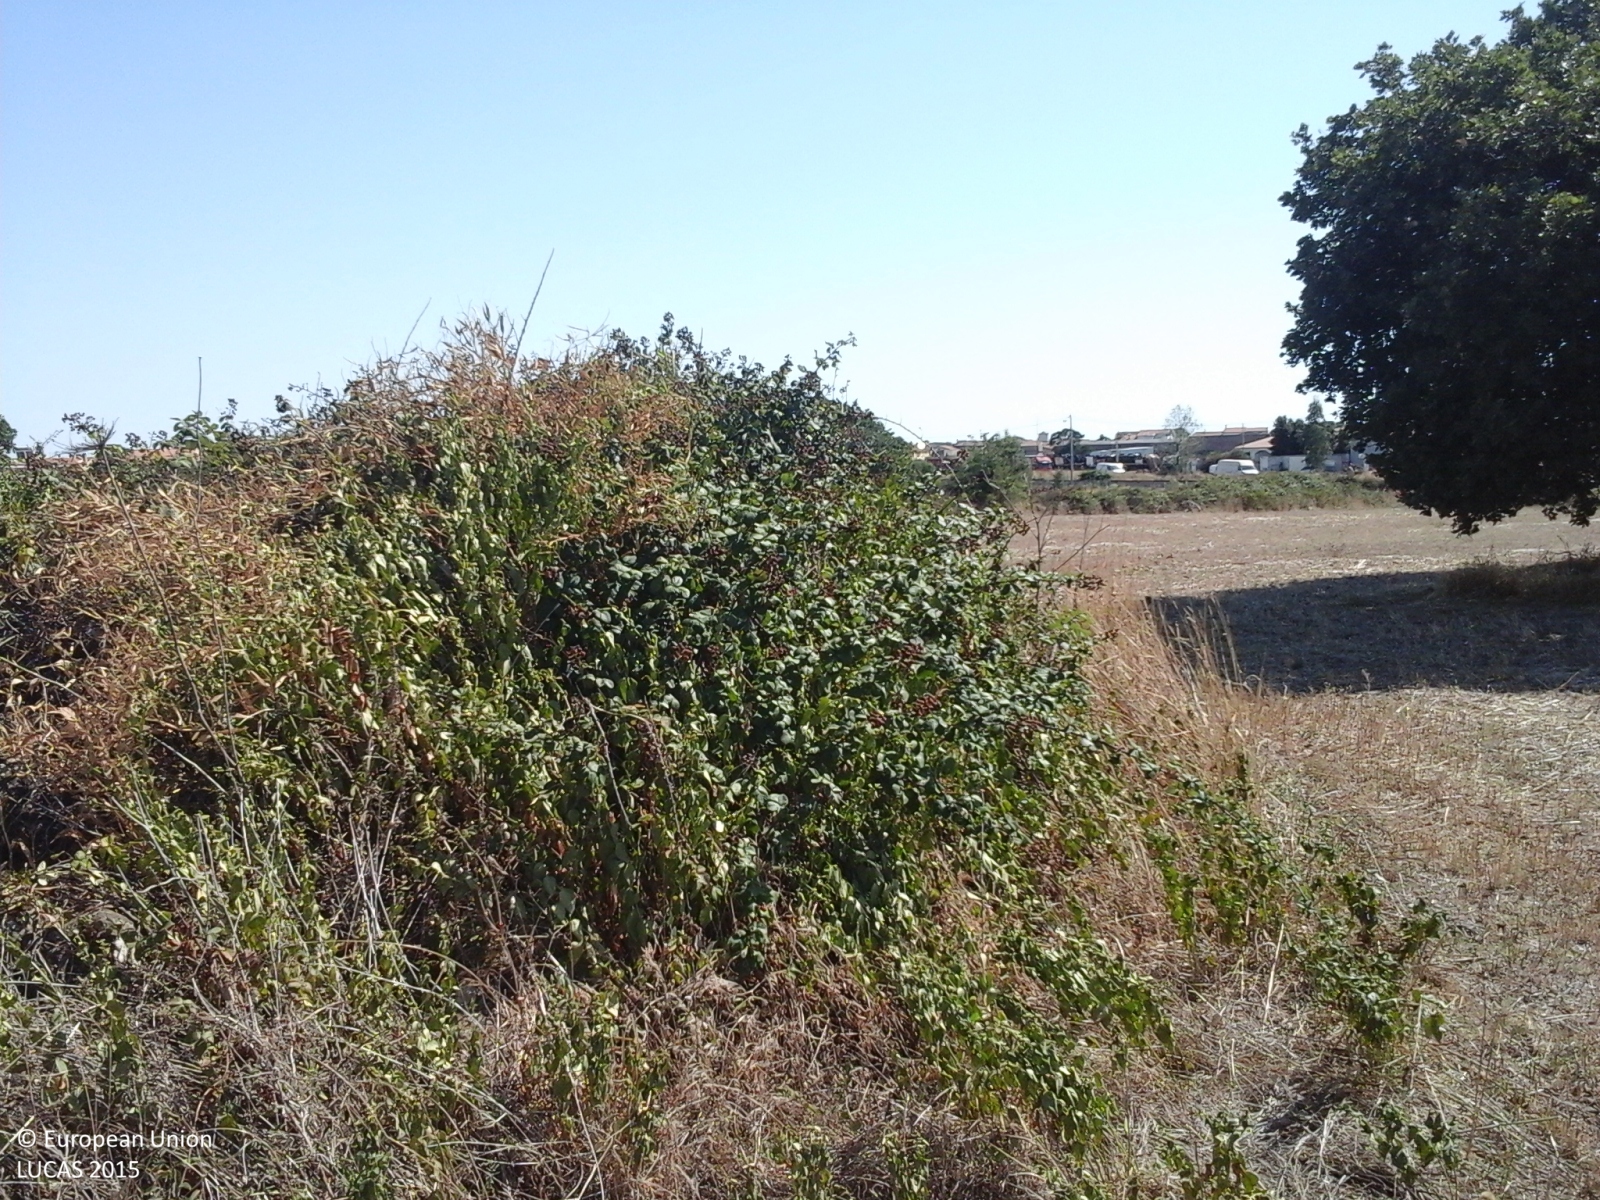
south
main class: Grassland
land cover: Grassland without tree/shrub cover
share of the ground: > 75 %
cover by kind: herbaceous plants 100 %
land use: Agriculture (excluding fallow land and kitchen gardens)
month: August
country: IT
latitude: 40.1335
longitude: 8.8210
